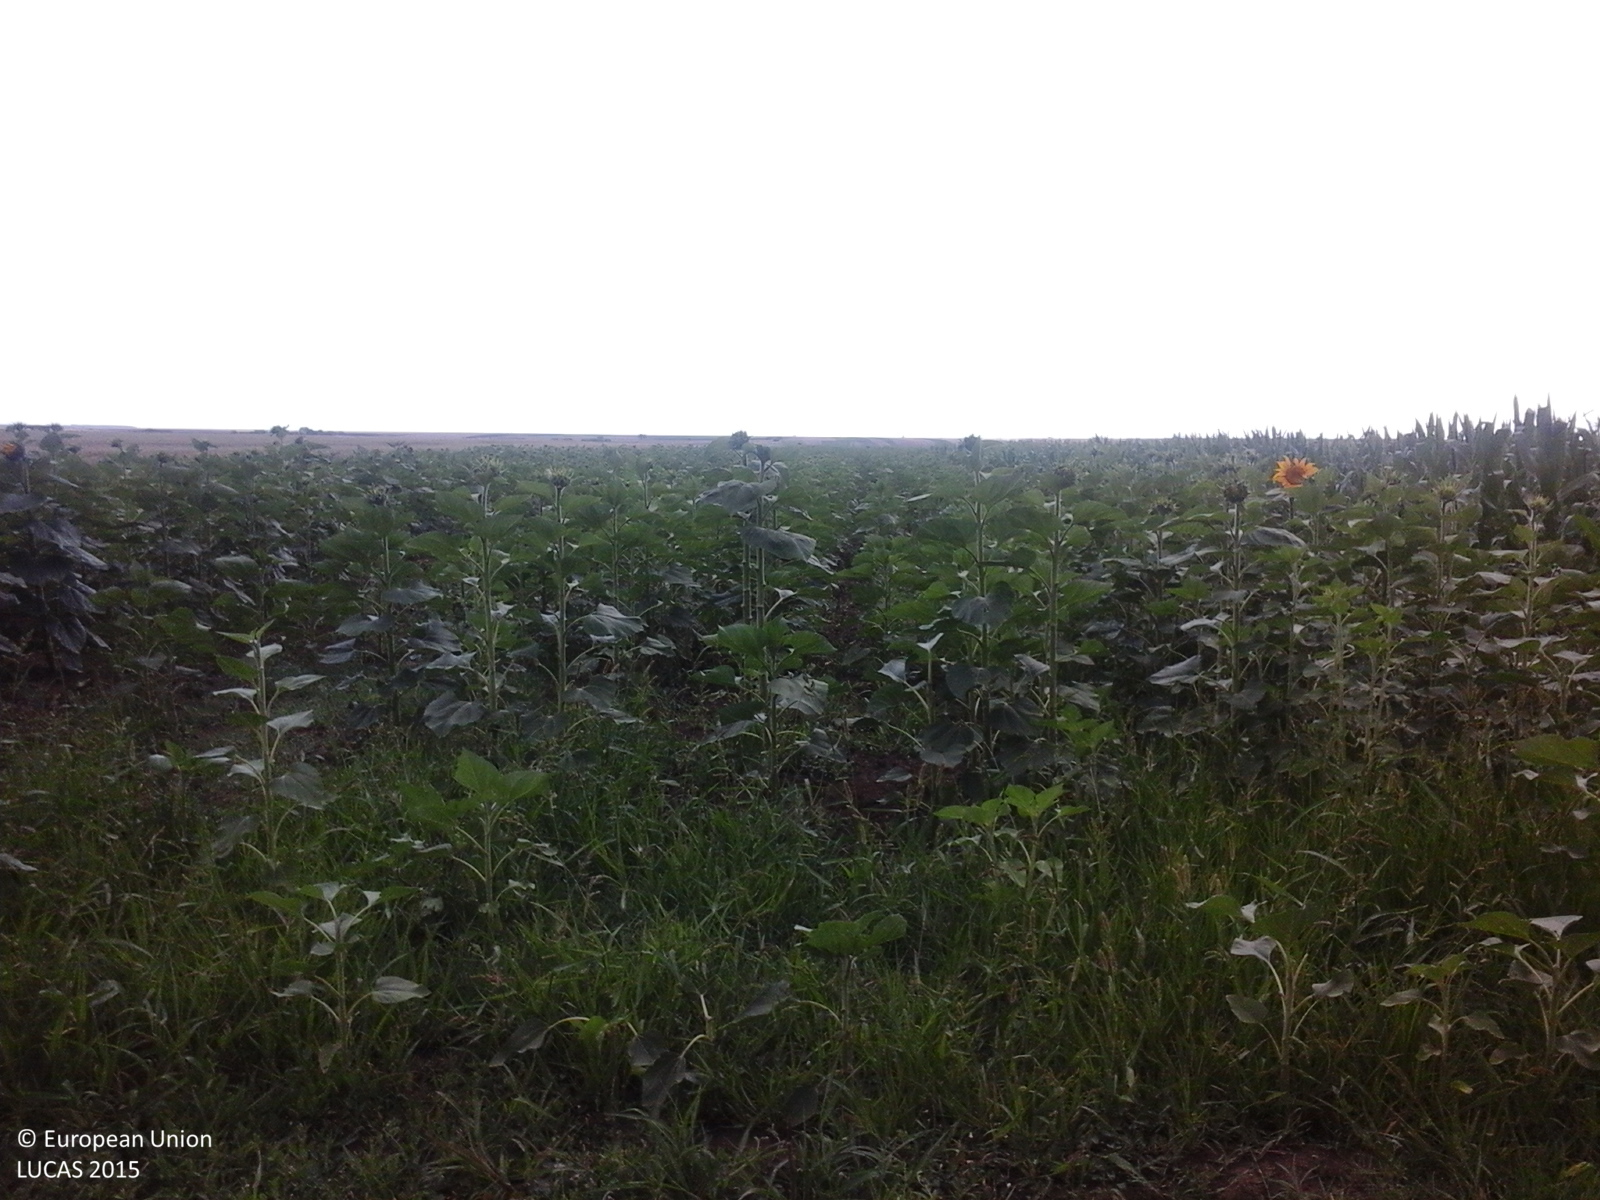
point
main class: Cropland
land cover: Sunflower
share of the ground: > 75 %
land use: Agriculture (excluding fallow land and kitchen gardens)
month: July
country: RO
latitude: 44.0848
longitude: 24.8227
